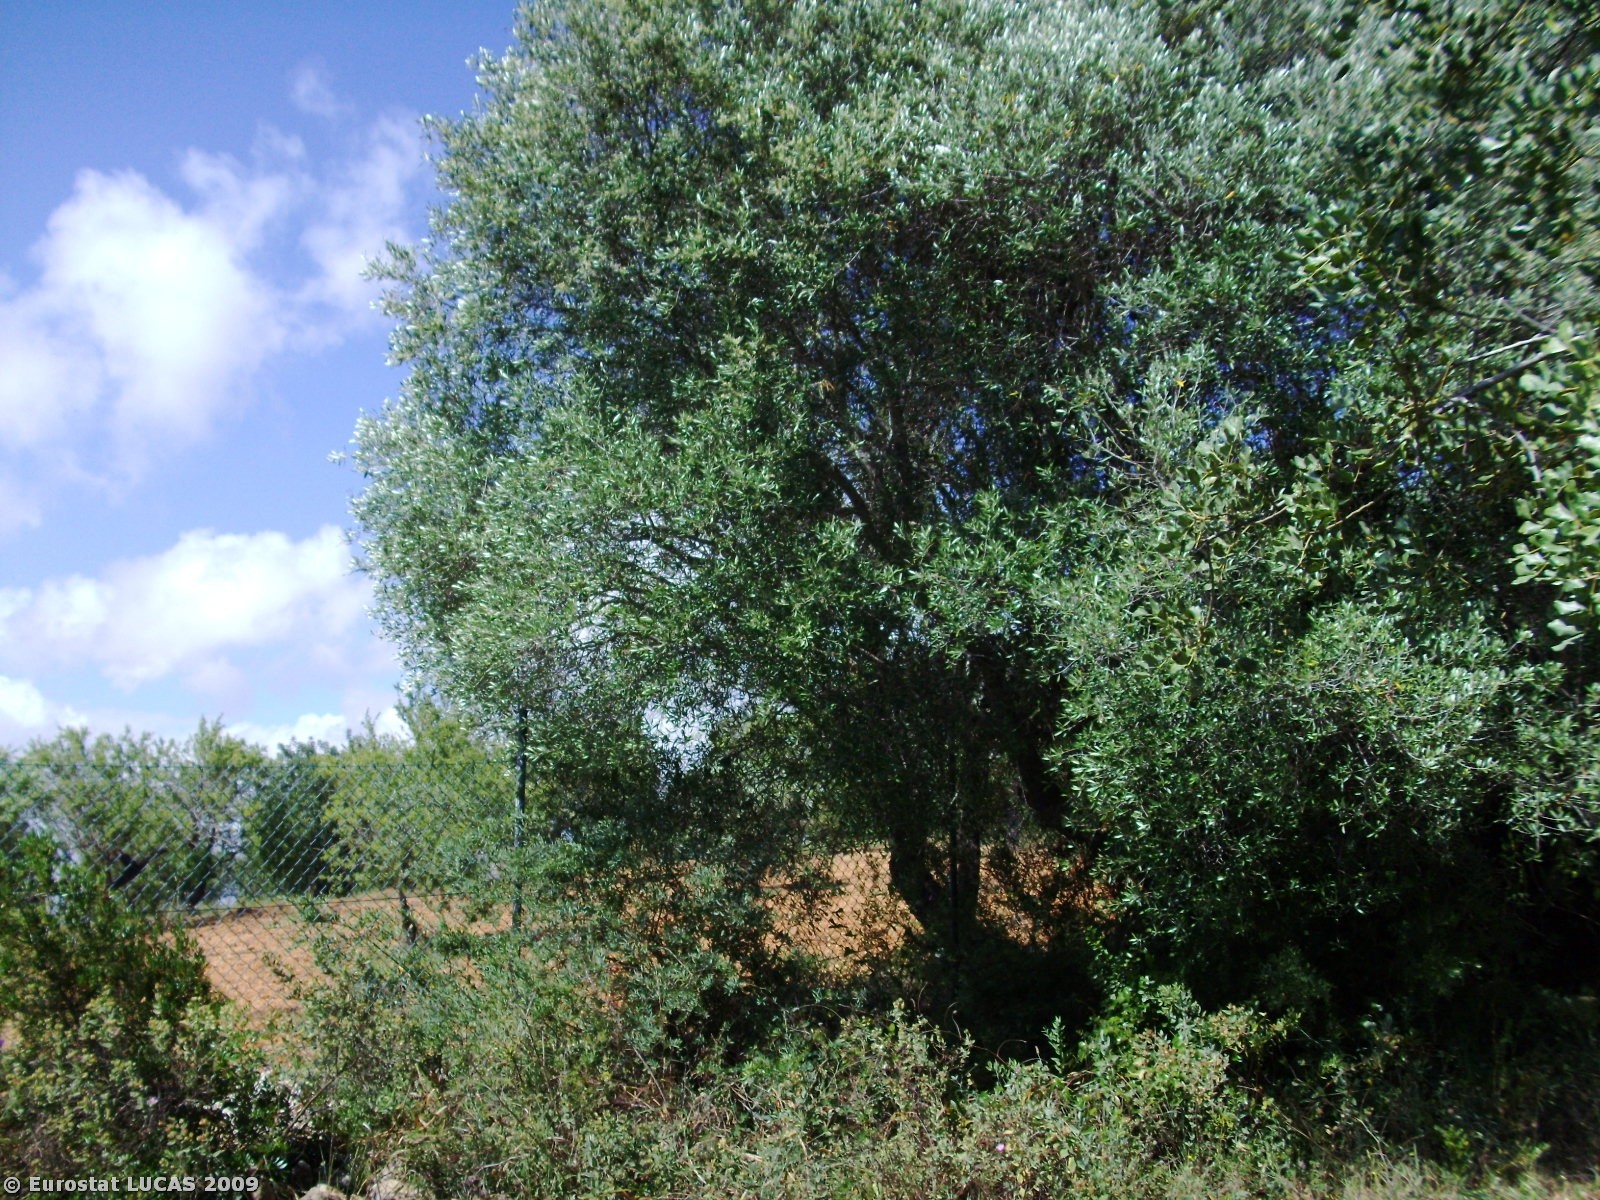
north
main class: Cropland
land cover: Permanent industrial crops
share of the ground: 10 - 25 %
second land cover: Spontaneously vegetated surfaces
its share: 50 - 75 %
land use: Agriculture (excluding fallow land and kitchen gardens)
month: May
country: PT
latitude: 37.1471
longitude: -8.2696
